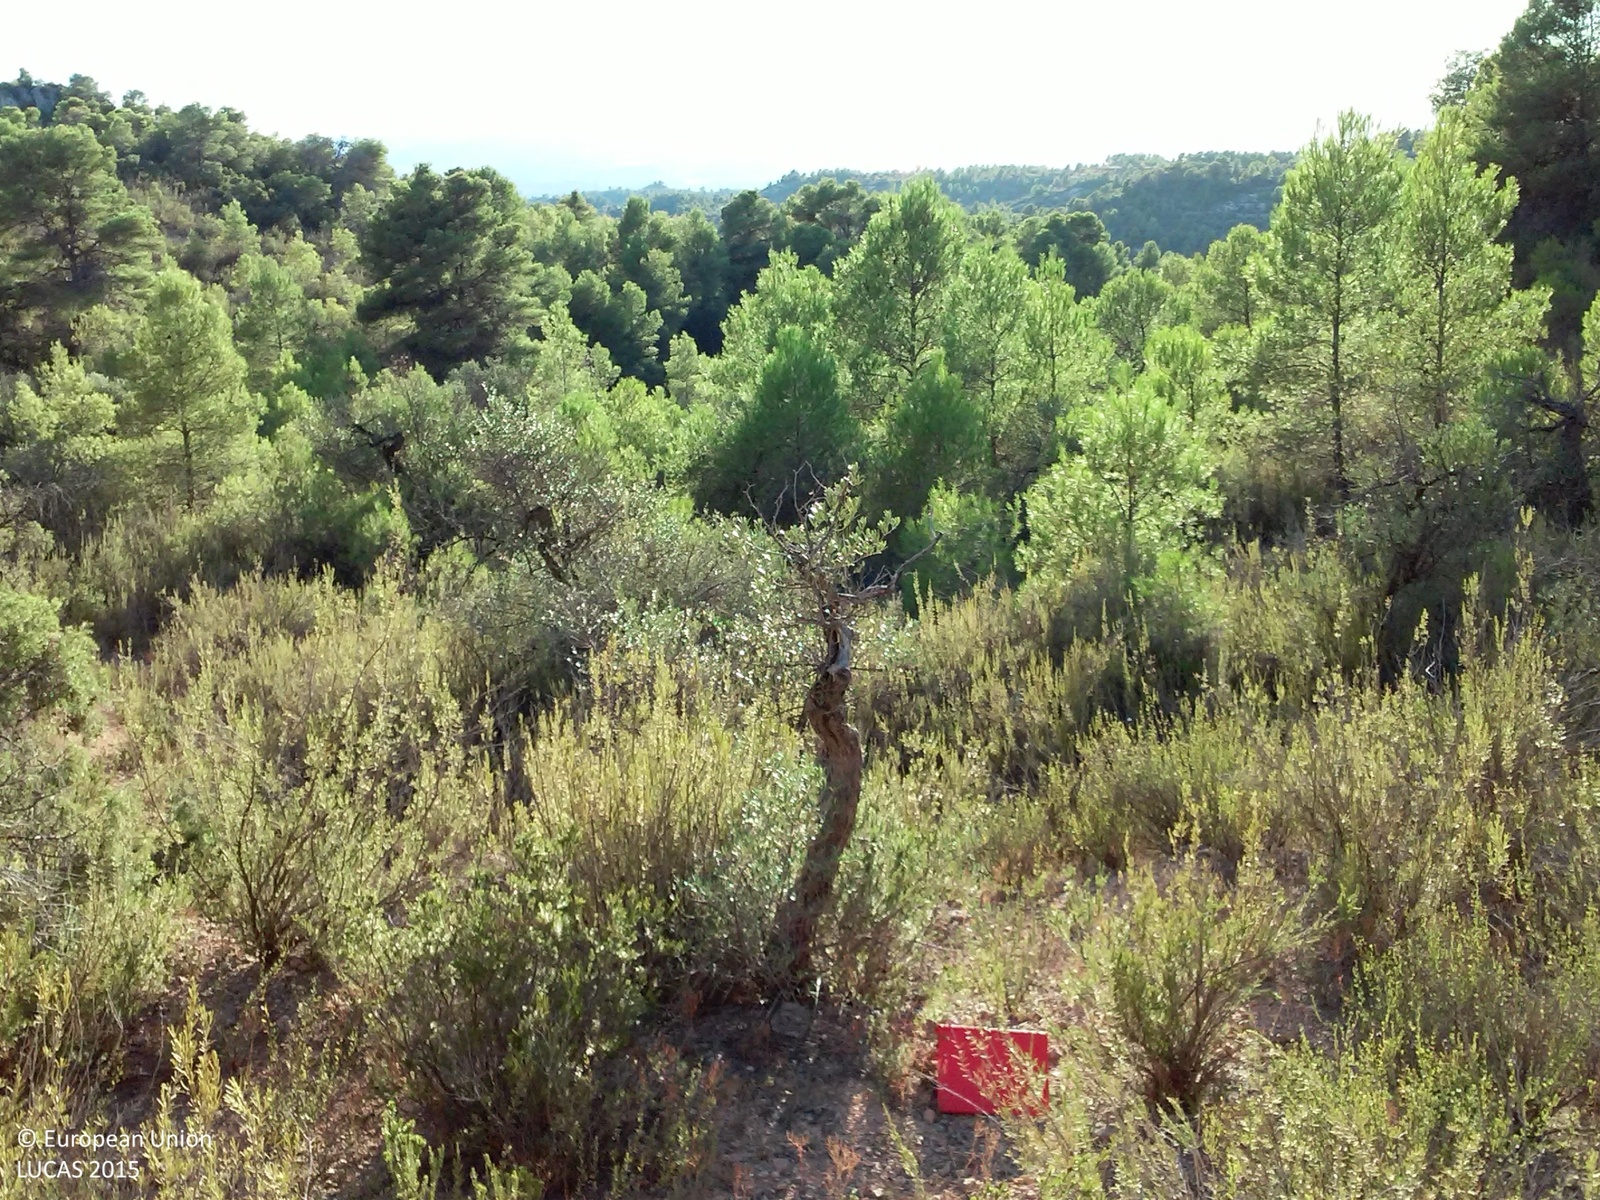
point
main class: Shrubland
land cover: Shrubland with sparse tree cover
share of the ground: 10 - 25 %
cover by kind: shrubs 50 %, consolidated bare surface 45 %, broadleaved forest trees 5 %
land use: Semi-natural and natural areas not in use
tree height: < 5 m
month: September
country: ES
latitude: 41.2210
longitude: 0.6510
